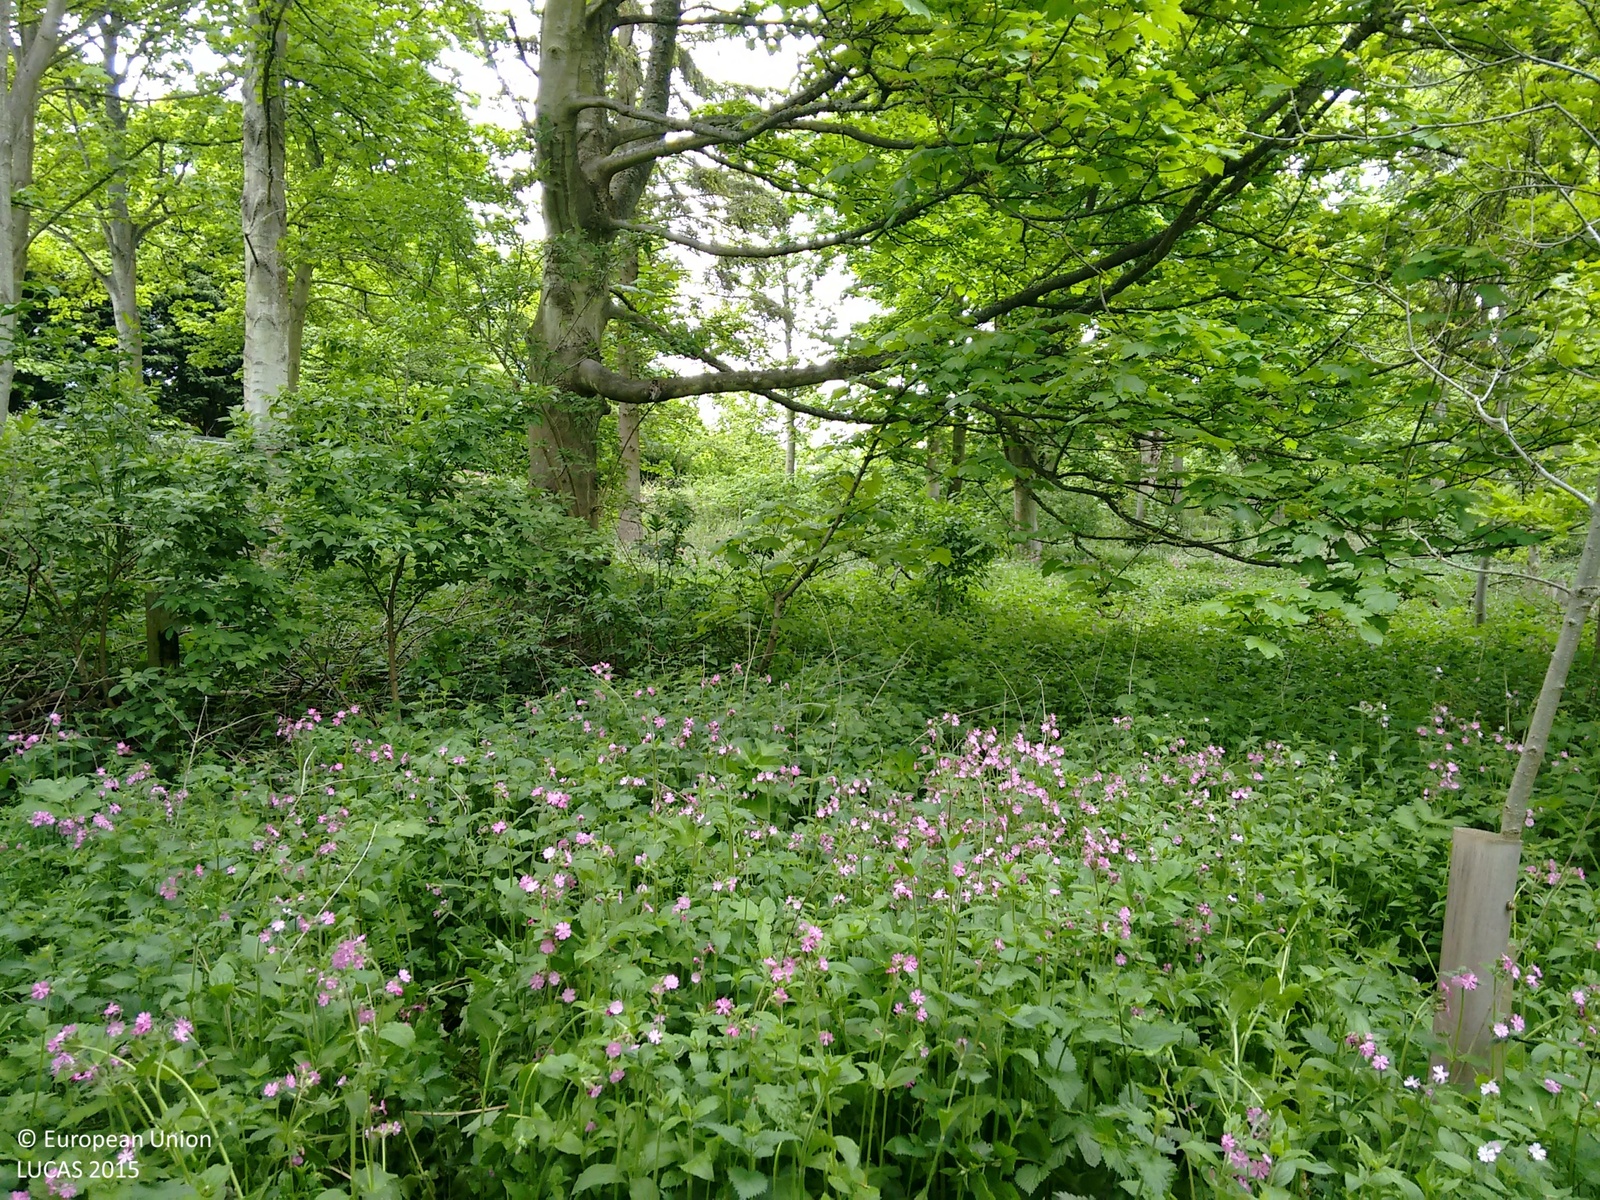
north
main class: Woodland
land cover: Broadleaved woodland
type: hemiboreal forest and nemoral coniferous forest and mixed broadleaved-coniferous forest
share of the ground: > 75 %
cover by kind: broadleaved forest trees 80 %, coniferous forest trees 10 %, shrubs 5 %, herbaceous plants 5 %
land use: Semi-natural and natural areas not in use
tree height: > 5 m
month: May
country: GB
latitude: 55.8481
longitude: -2.1125
